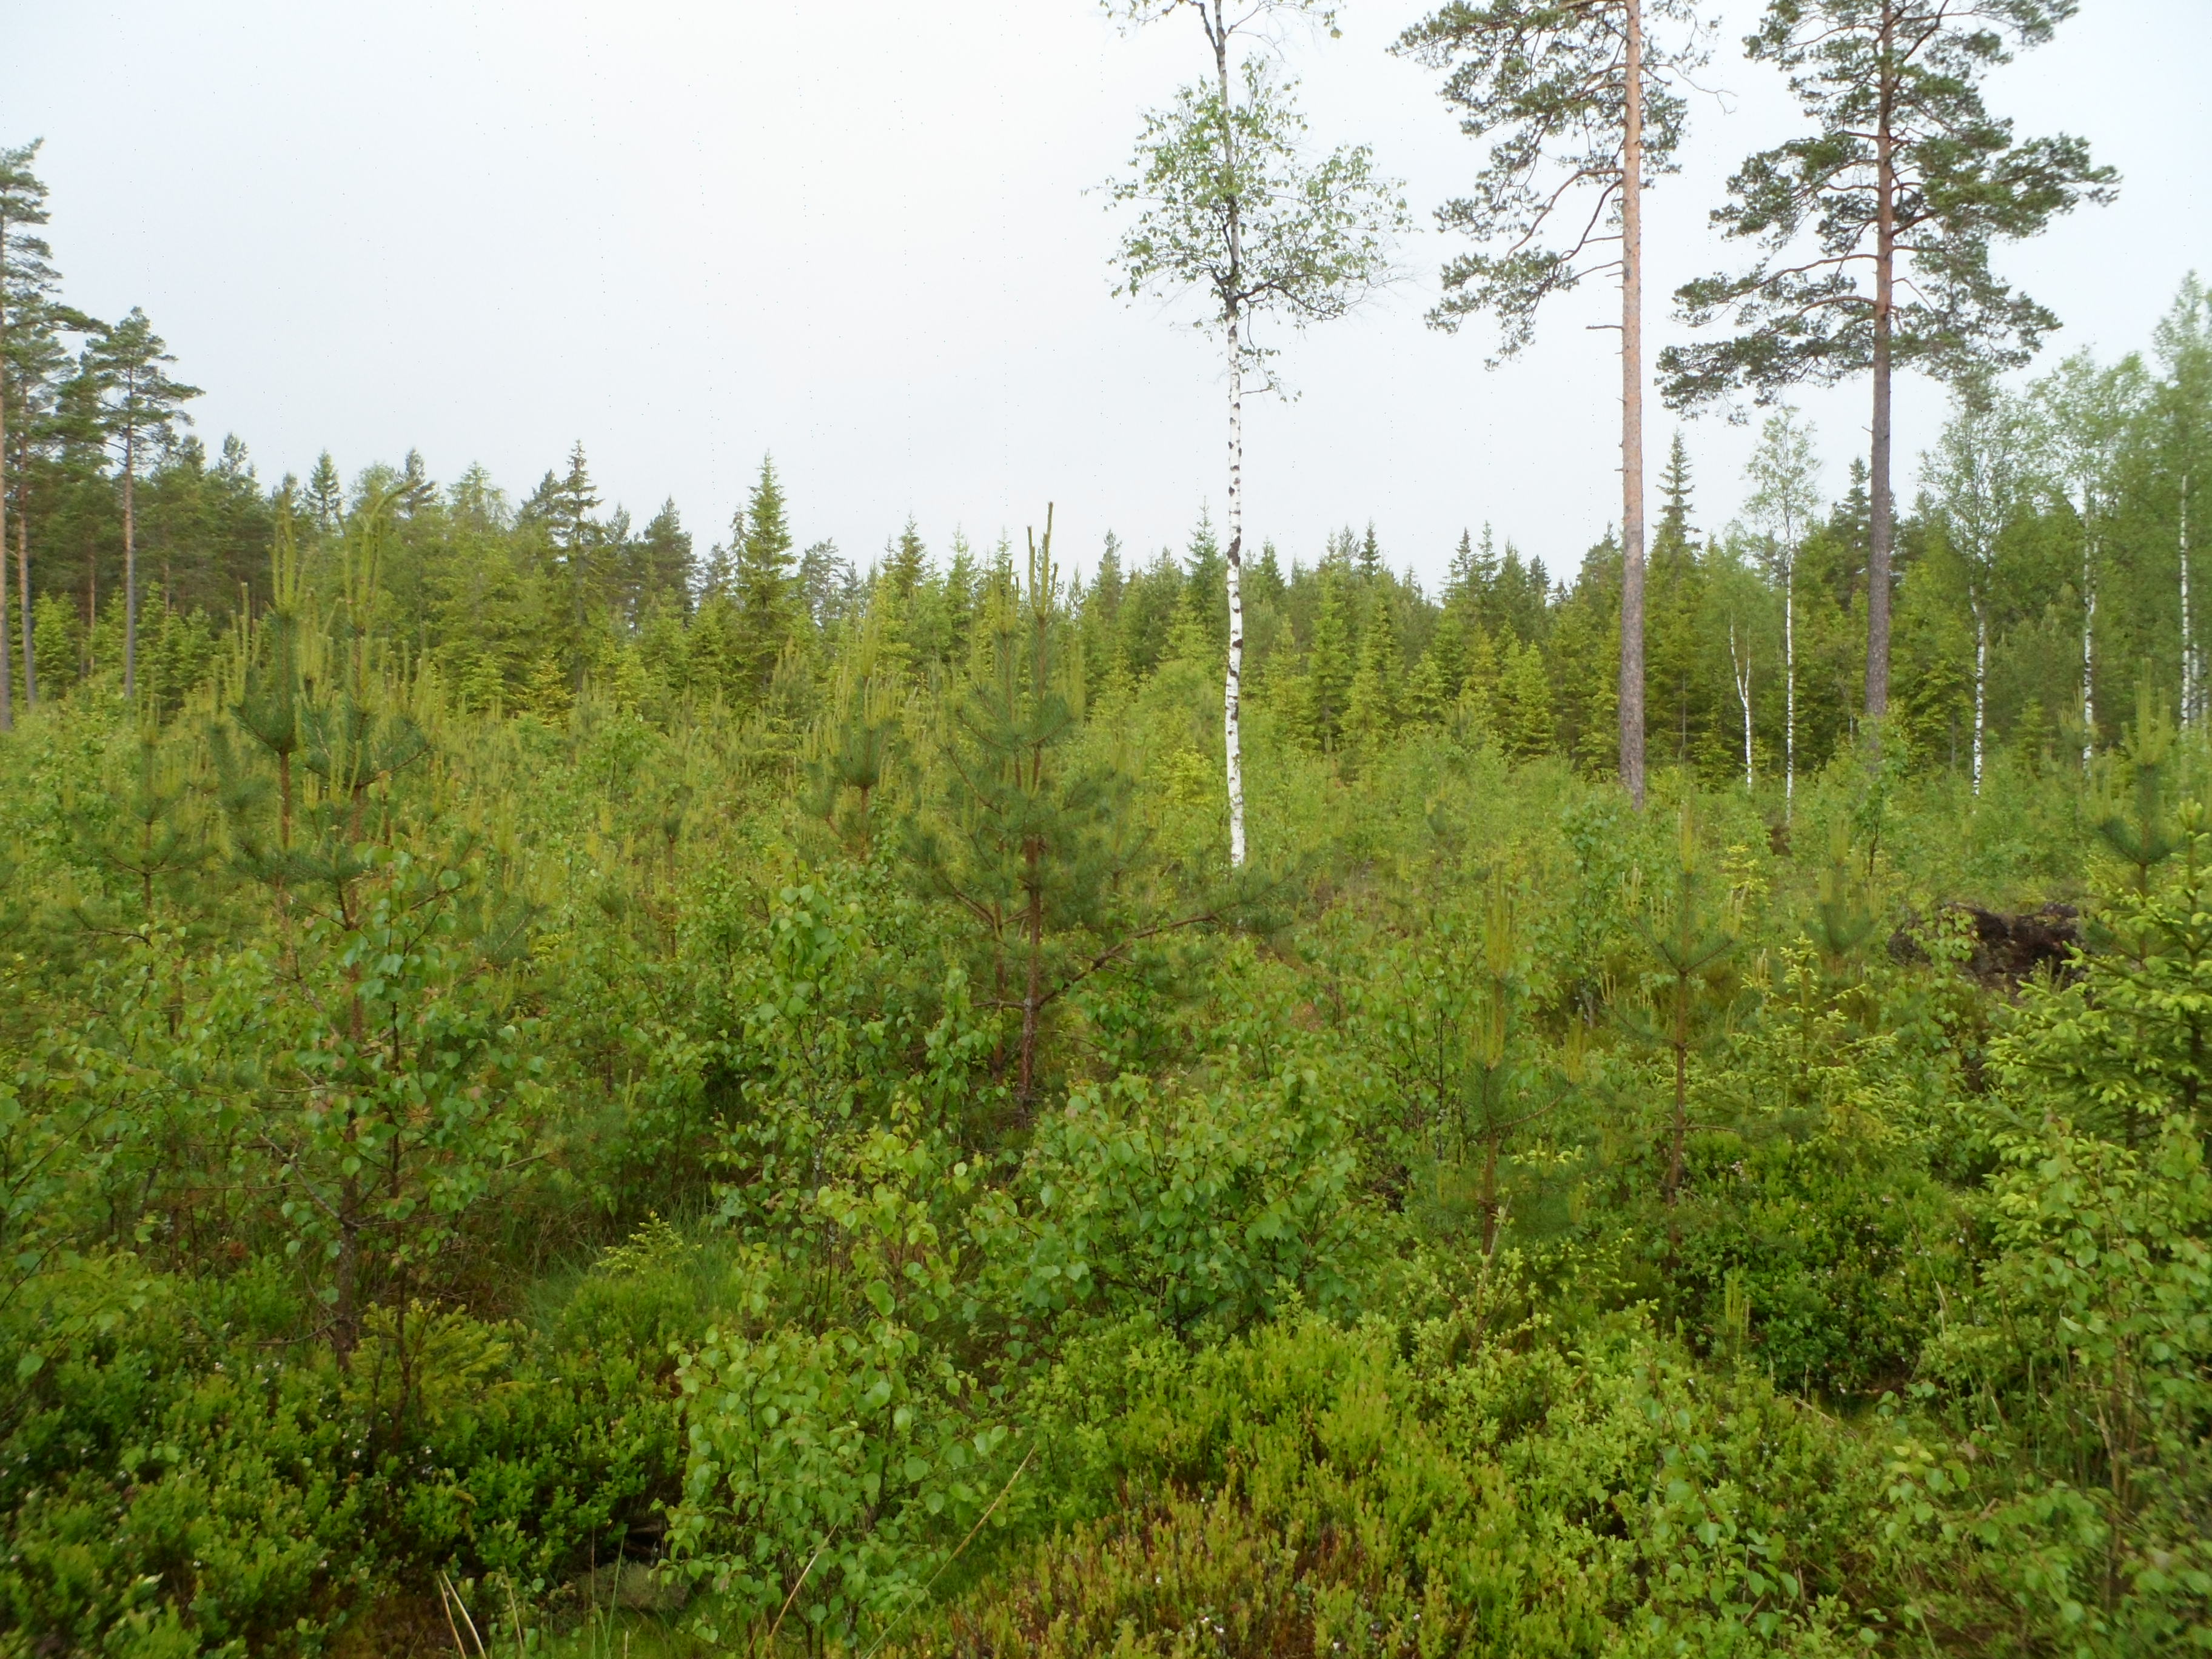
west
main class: Woodland
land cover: Pine dominated mixed woodland
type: boreal forest
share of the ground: 50 - 75 %
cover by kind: shrubs 30 %, coniferous forest trees 25 %, broadleaved forest trees 25 %, lichens and mosses 15 %, herbaceous plants 5 %
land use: Forestry
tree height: < 5 m
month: June
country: SE
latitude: 56.9064
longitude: 14.3484
